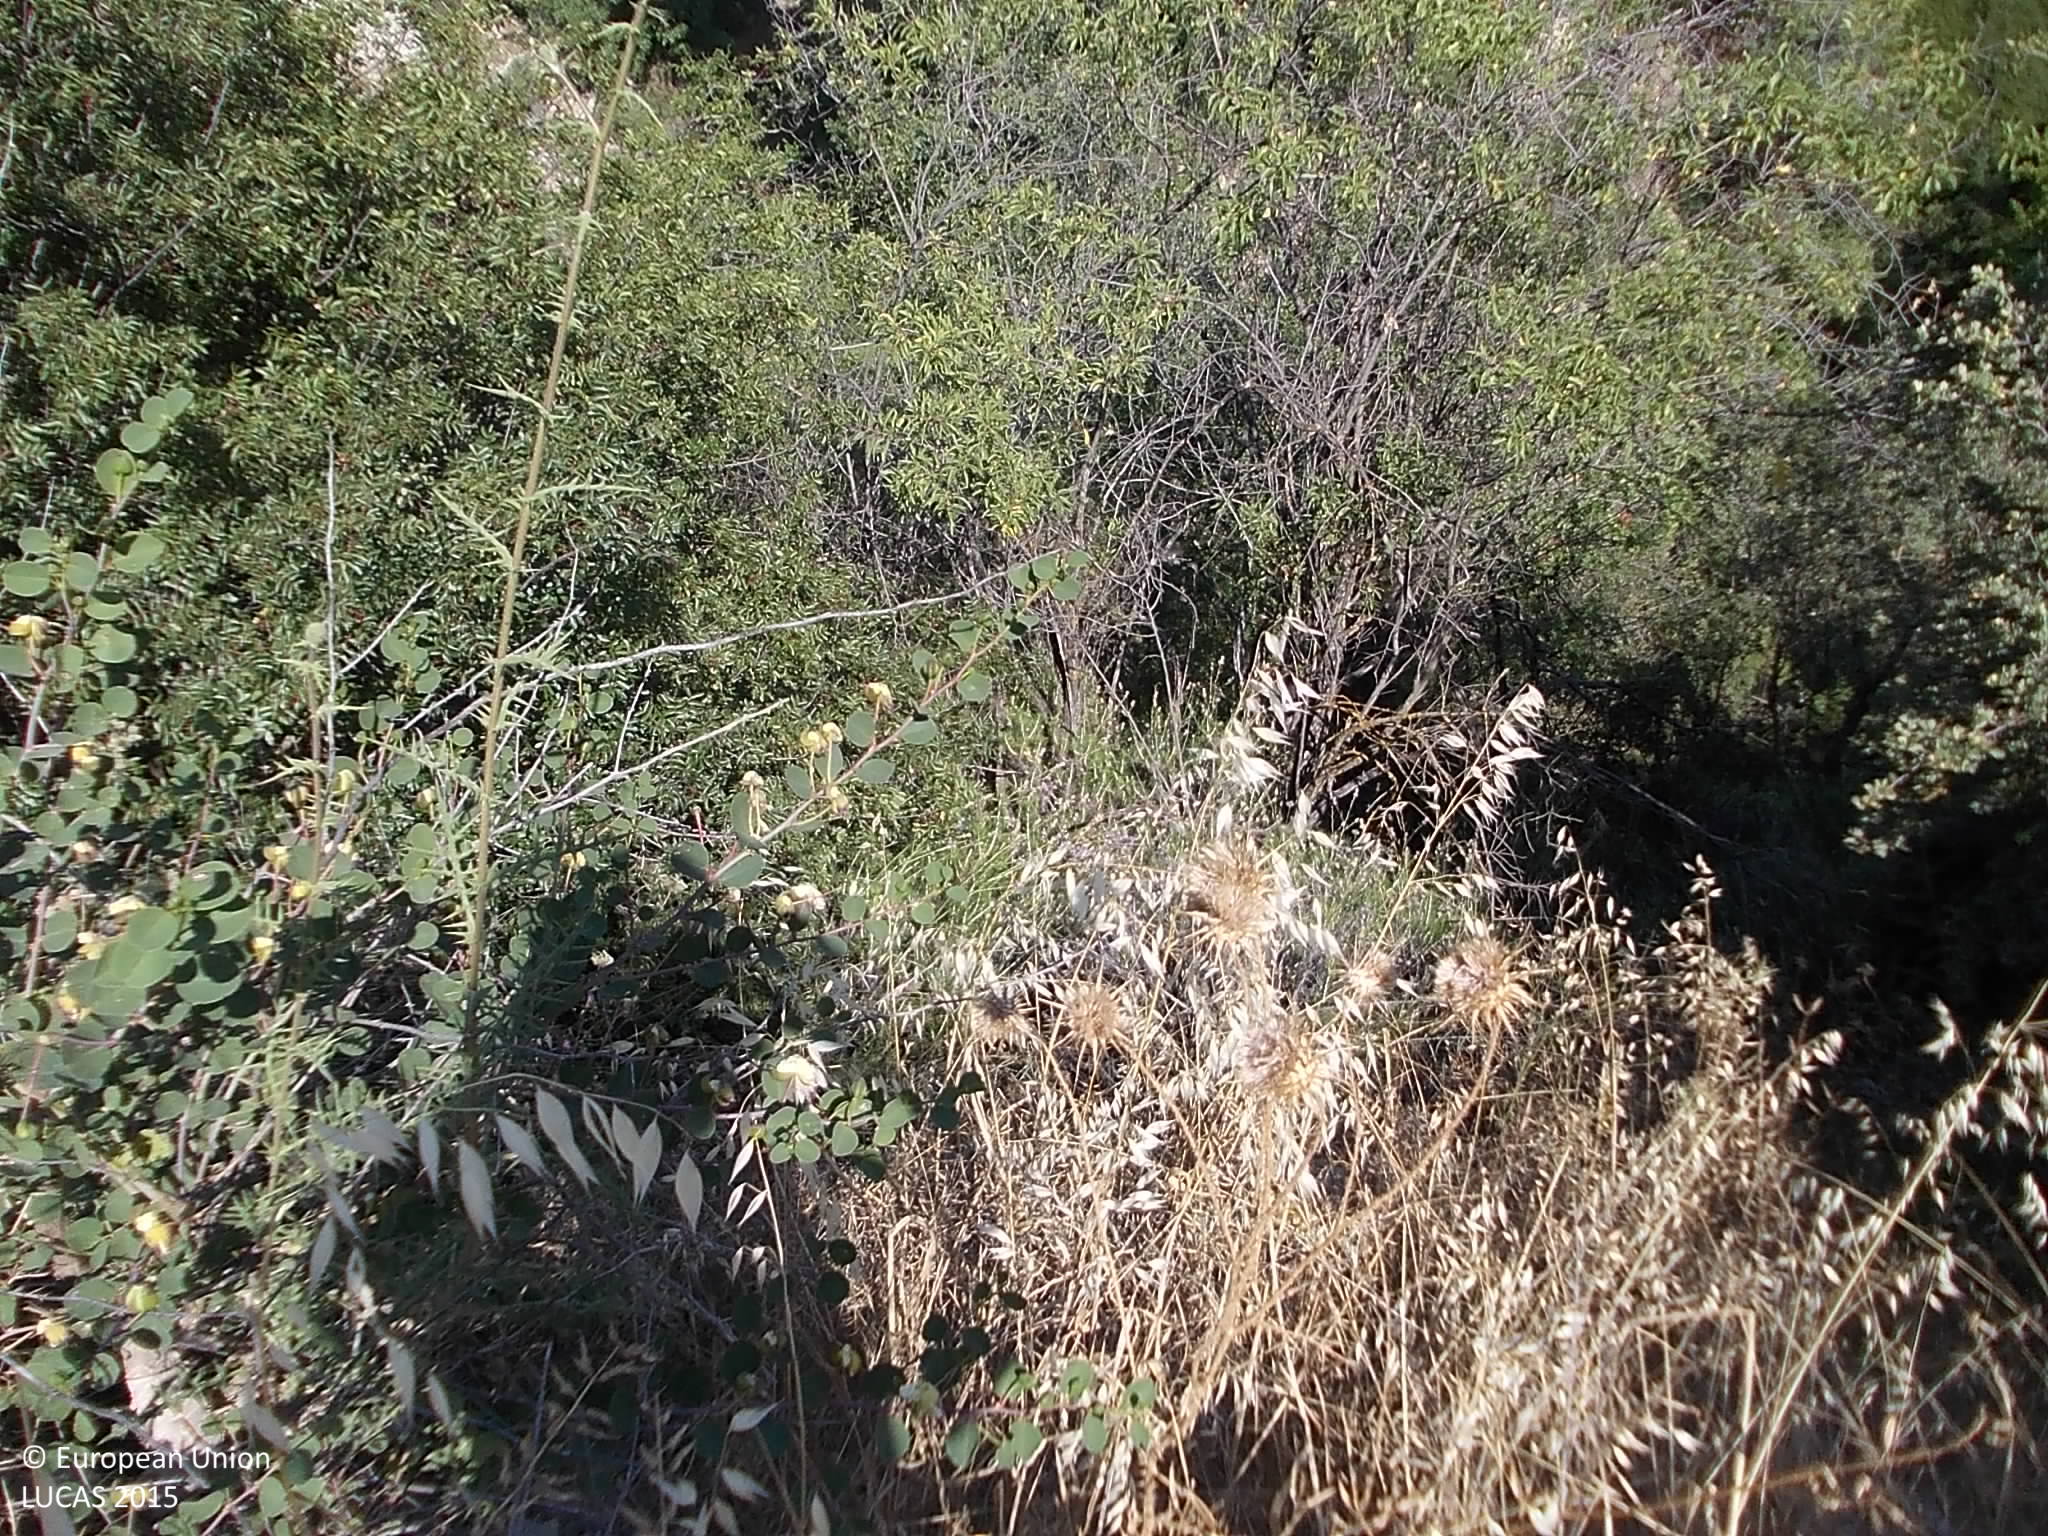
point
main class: Woodland
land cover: Broadleaved woodland
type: broadleaved evergreen forest
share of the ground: > 75 %
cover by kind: broadleaved forest trees 75 %, shrubs 25 %
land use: Semi-natural and natural areas not in use
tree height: > 5 m
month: July
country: CY
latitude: 34.8358
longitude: 32.7618
